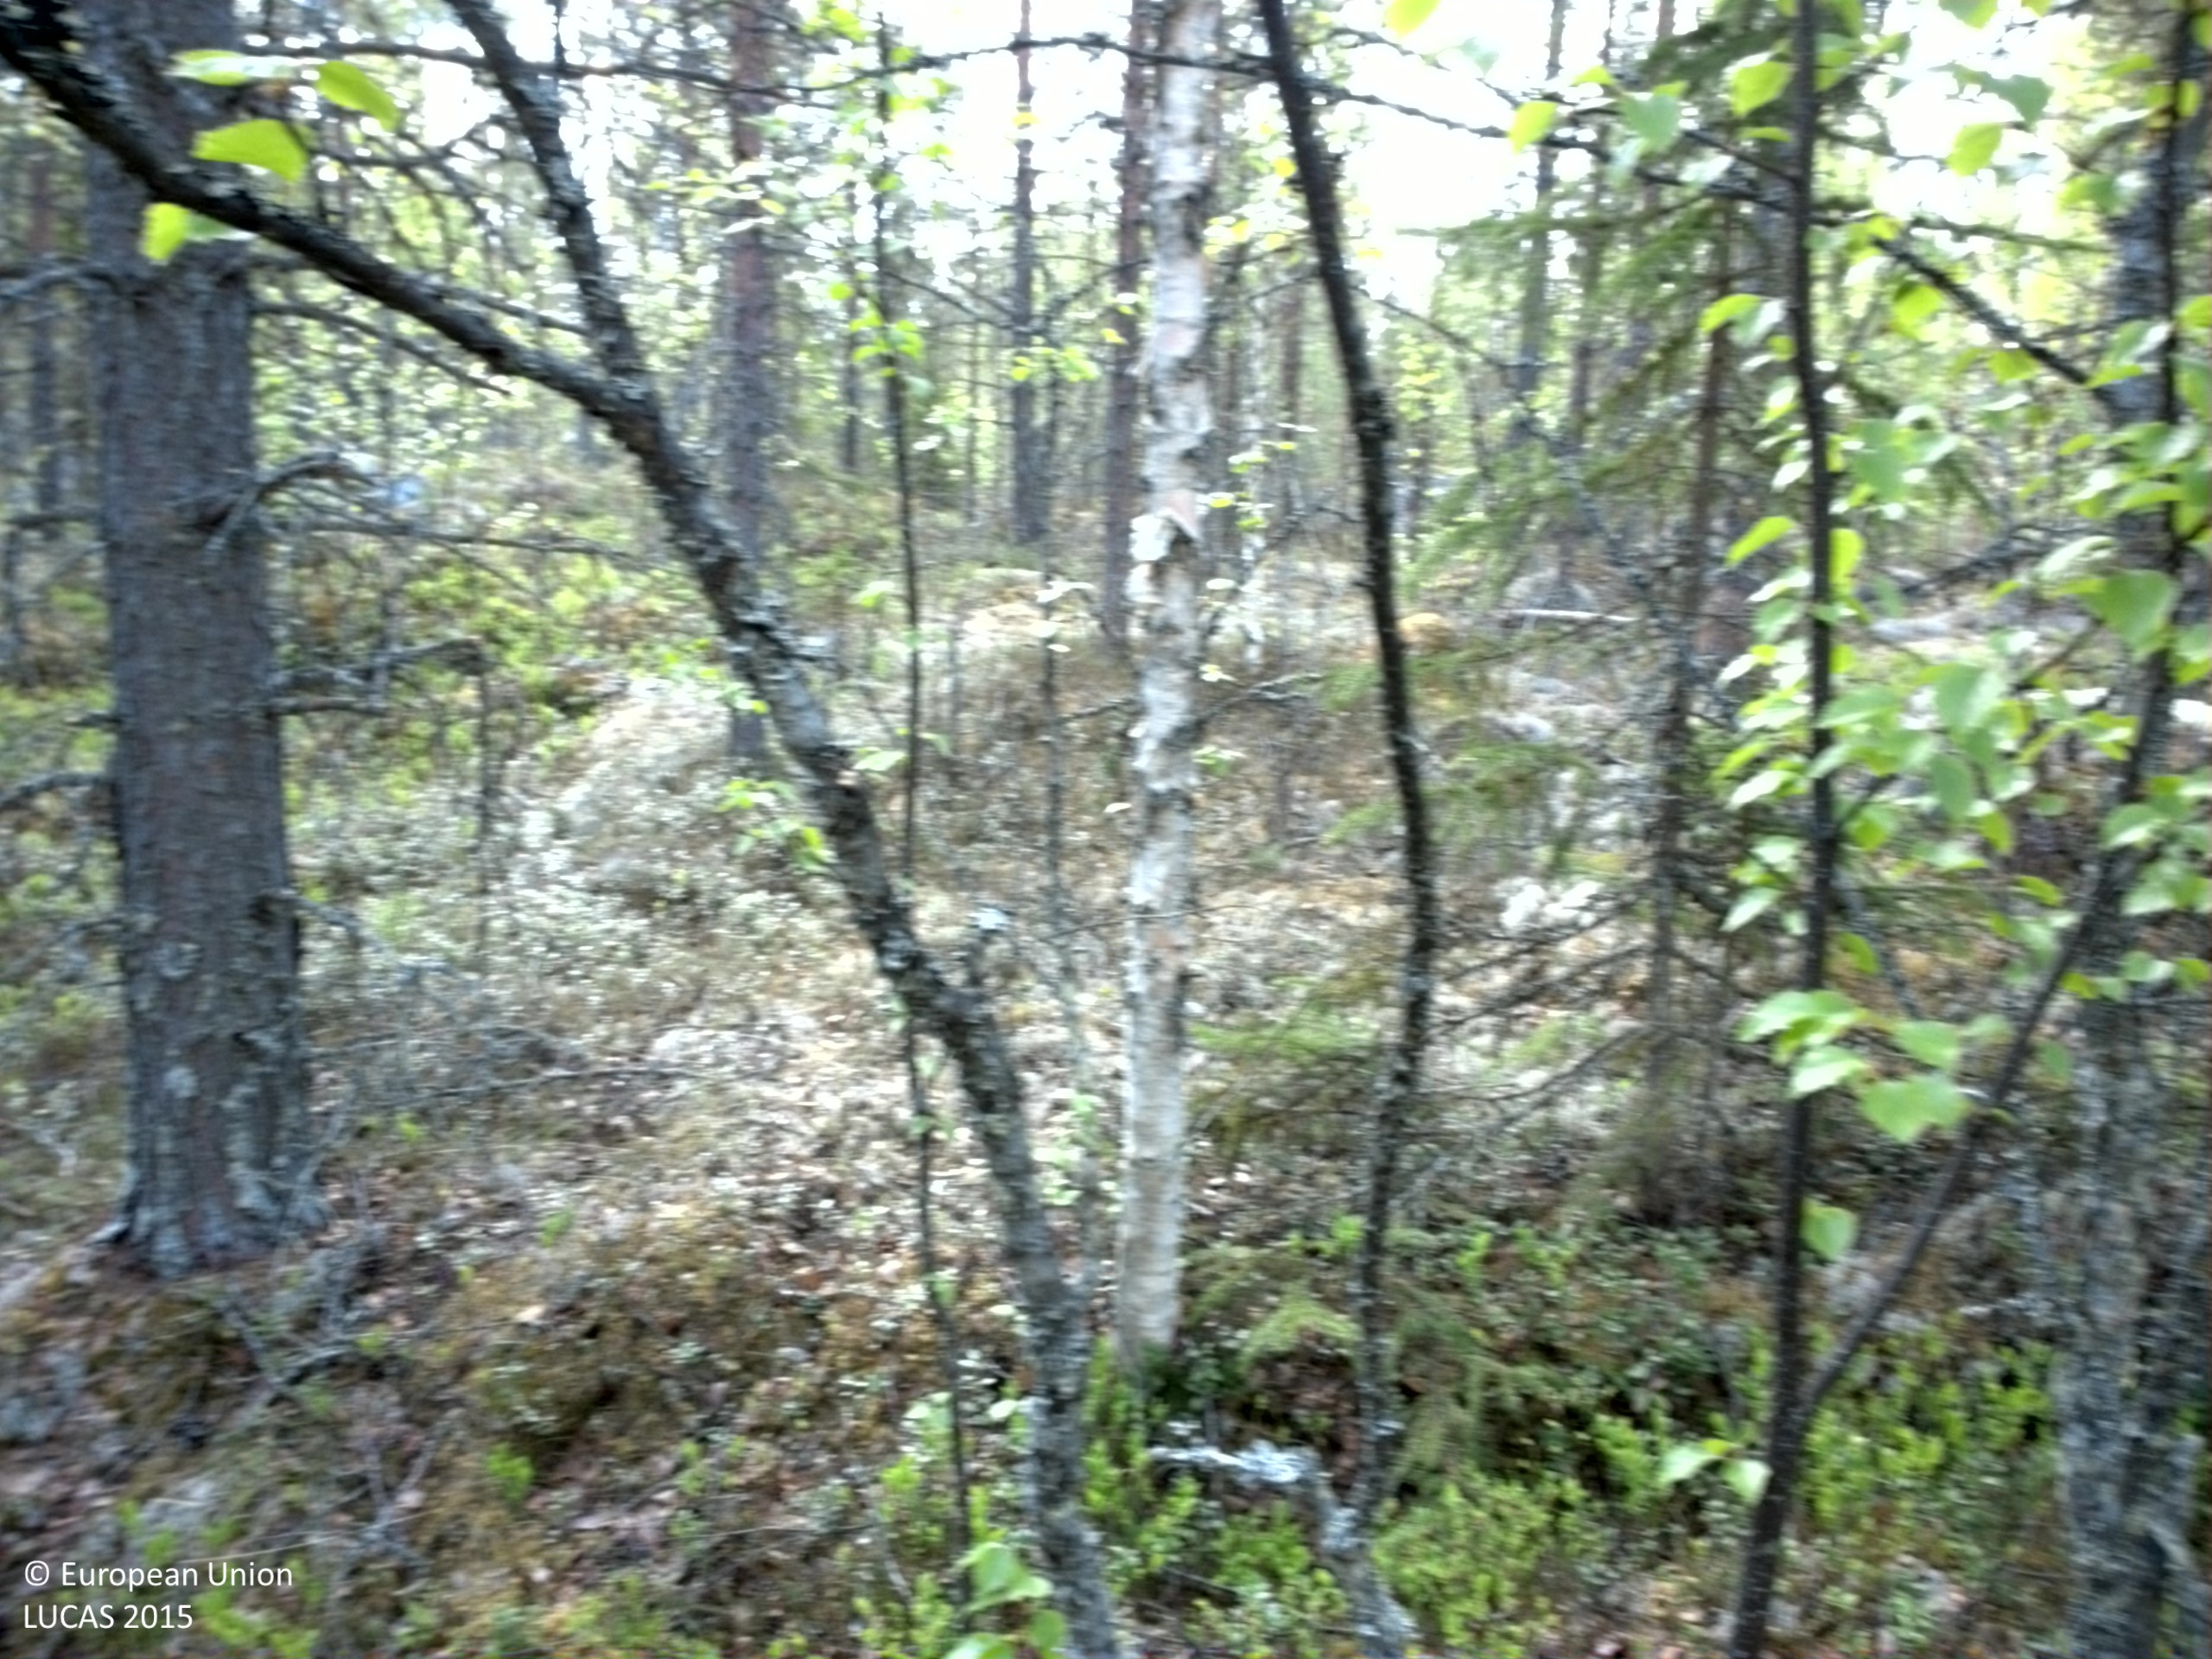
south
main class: Woodland
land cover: Pine dominated mixed woodland
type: boreal forest
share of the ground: 50 - 75 %
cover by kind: coniferous forest trees 50 %, shrubs 30 %, broadleaved forest trees 20 %
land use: Forestry
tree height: > 5 m
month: June
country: SE
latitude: 63.0204
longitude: 17.1881
